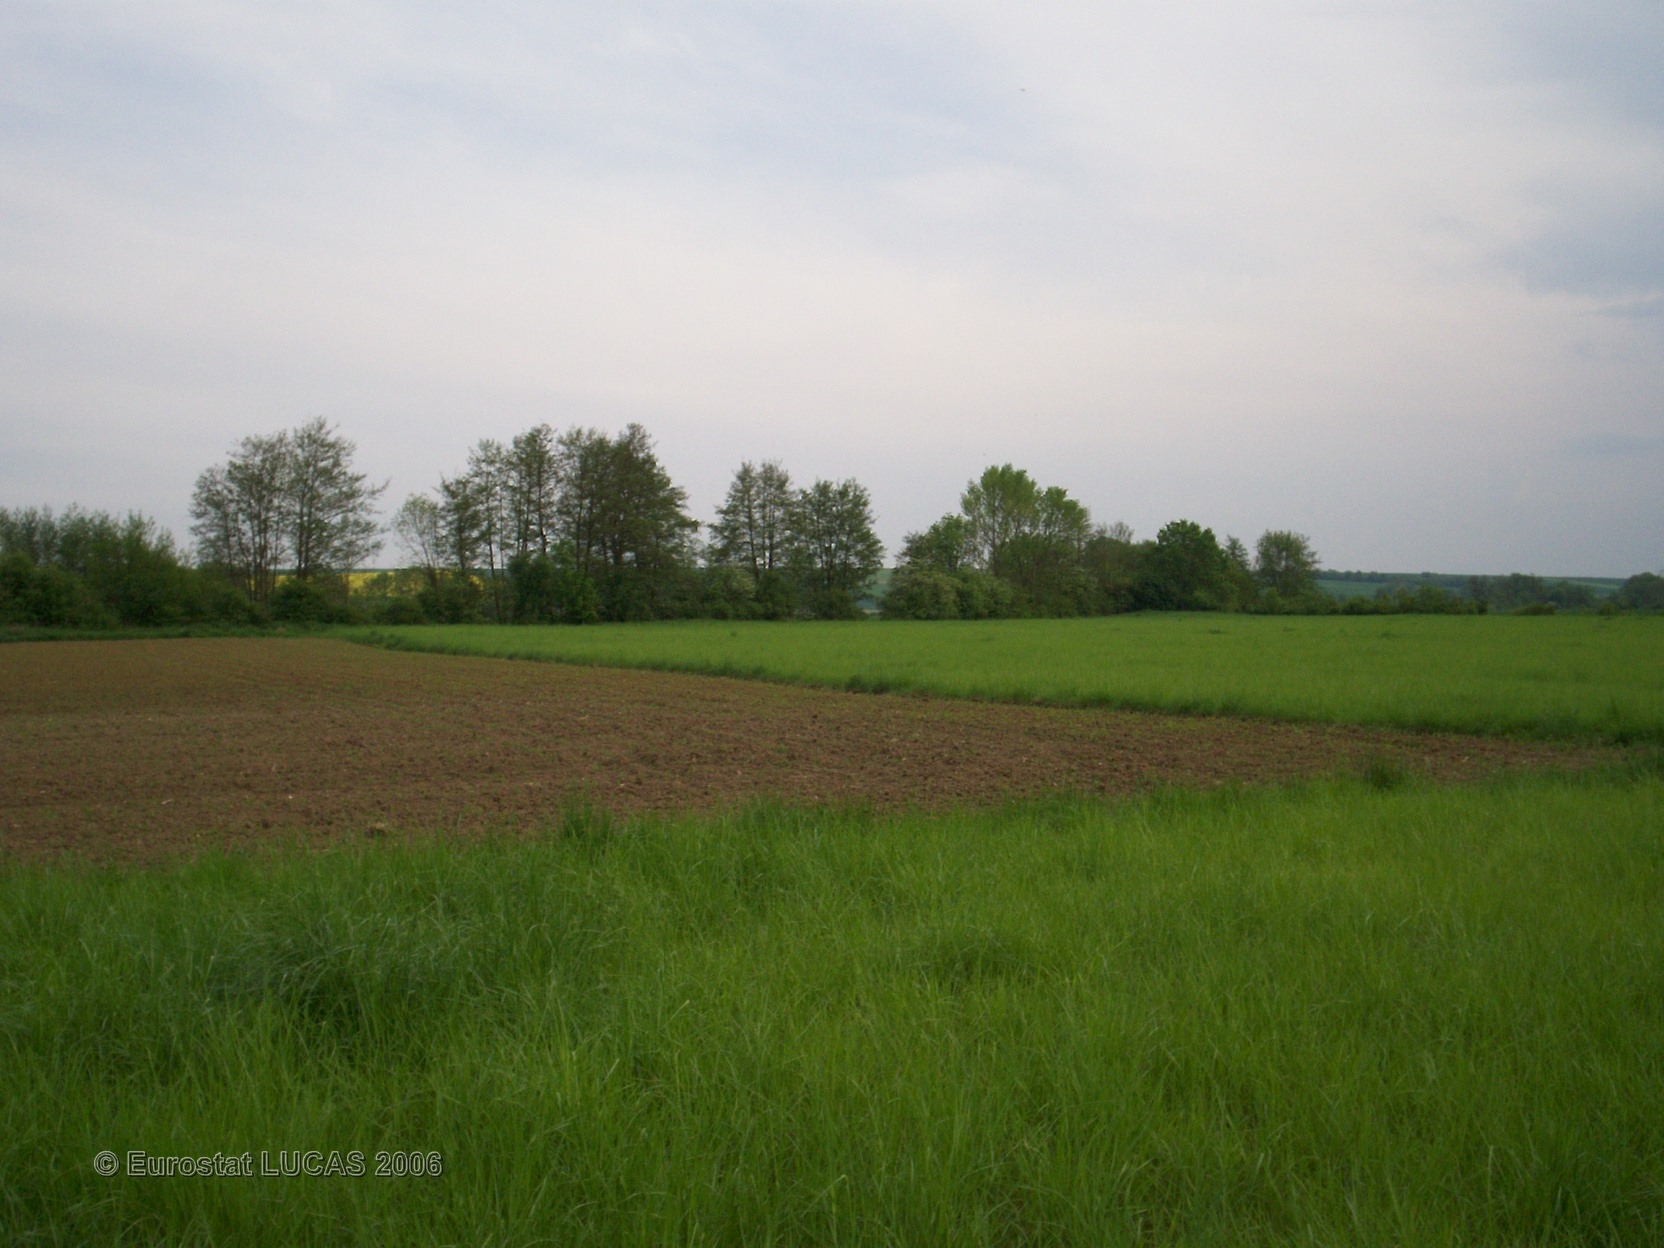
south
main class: Grassland
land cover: Grassland without tree/shrub cover
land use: Agriculture (excluding fallow land and kitchen gardens)
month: May
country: FR
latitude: 49.5556
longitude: 4.3141
